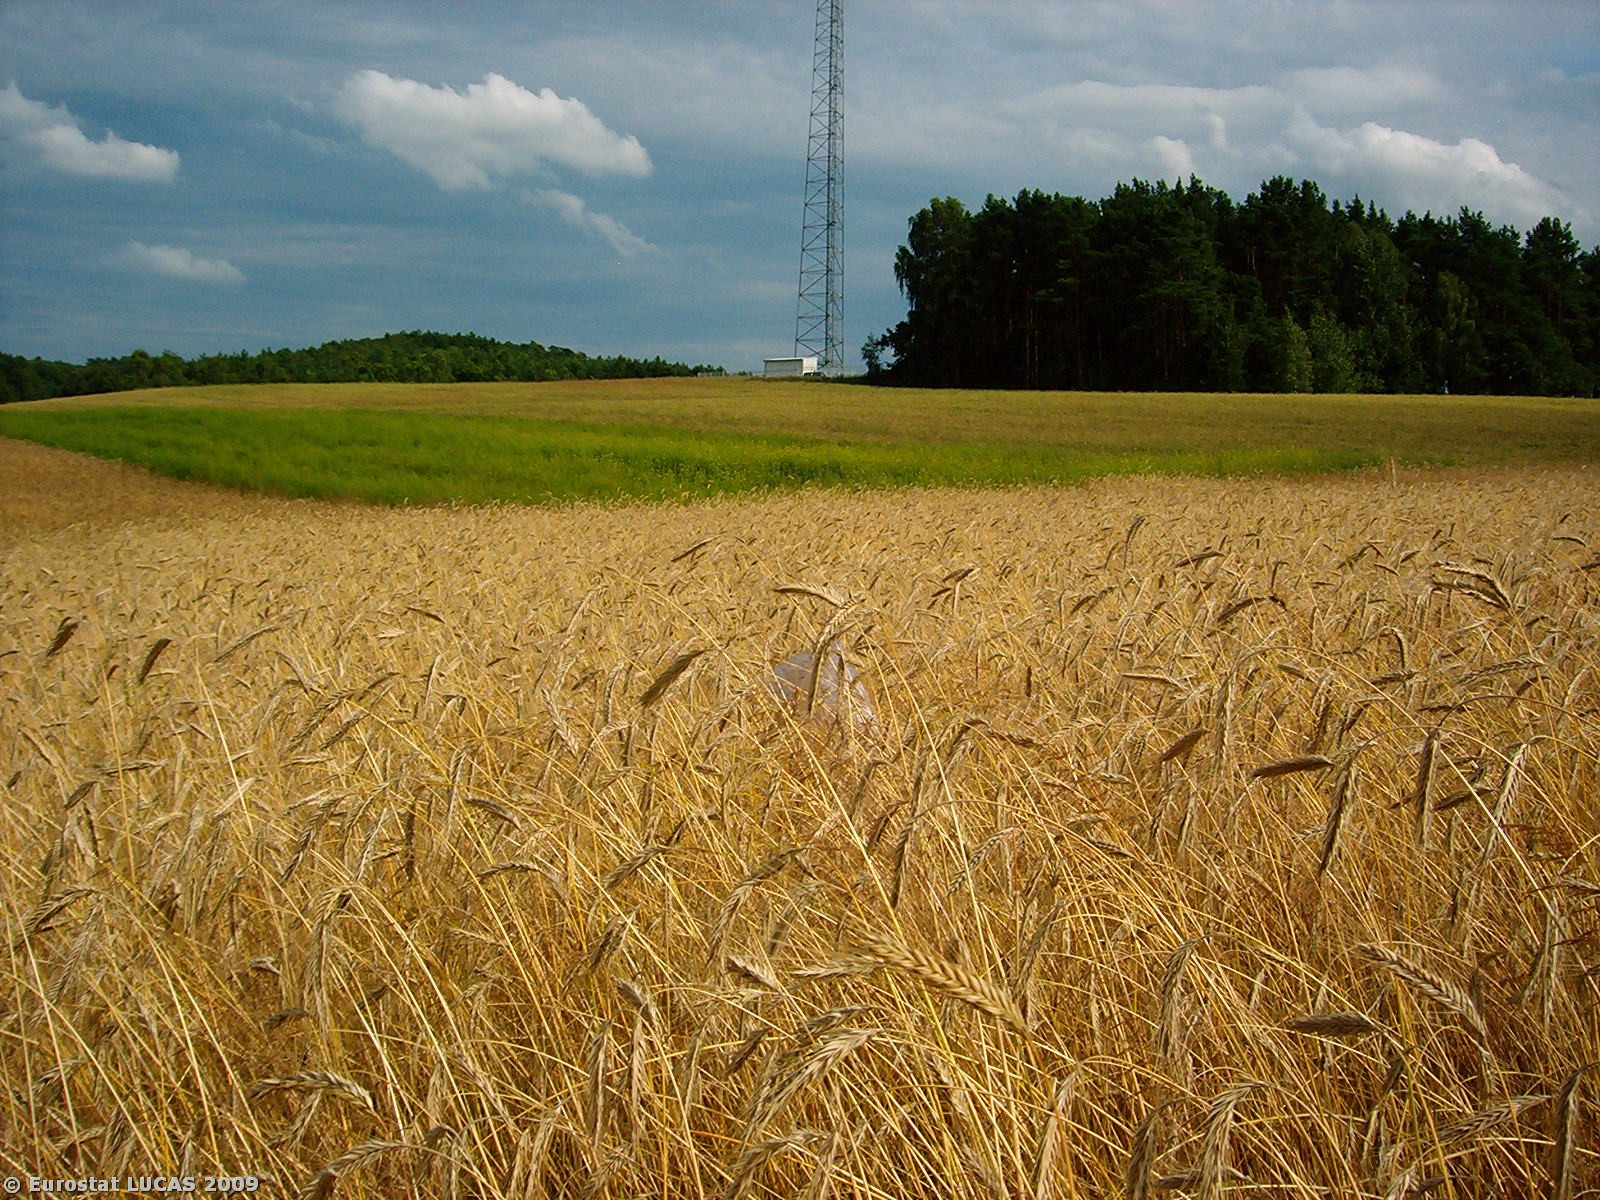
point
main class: Cropland
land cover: Triticale
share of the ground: 50 - 75 %
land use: Agriculture (excluding fallow land and kitchen gardens)
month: July
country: PL
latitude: 52.4605
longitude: 15.2279
